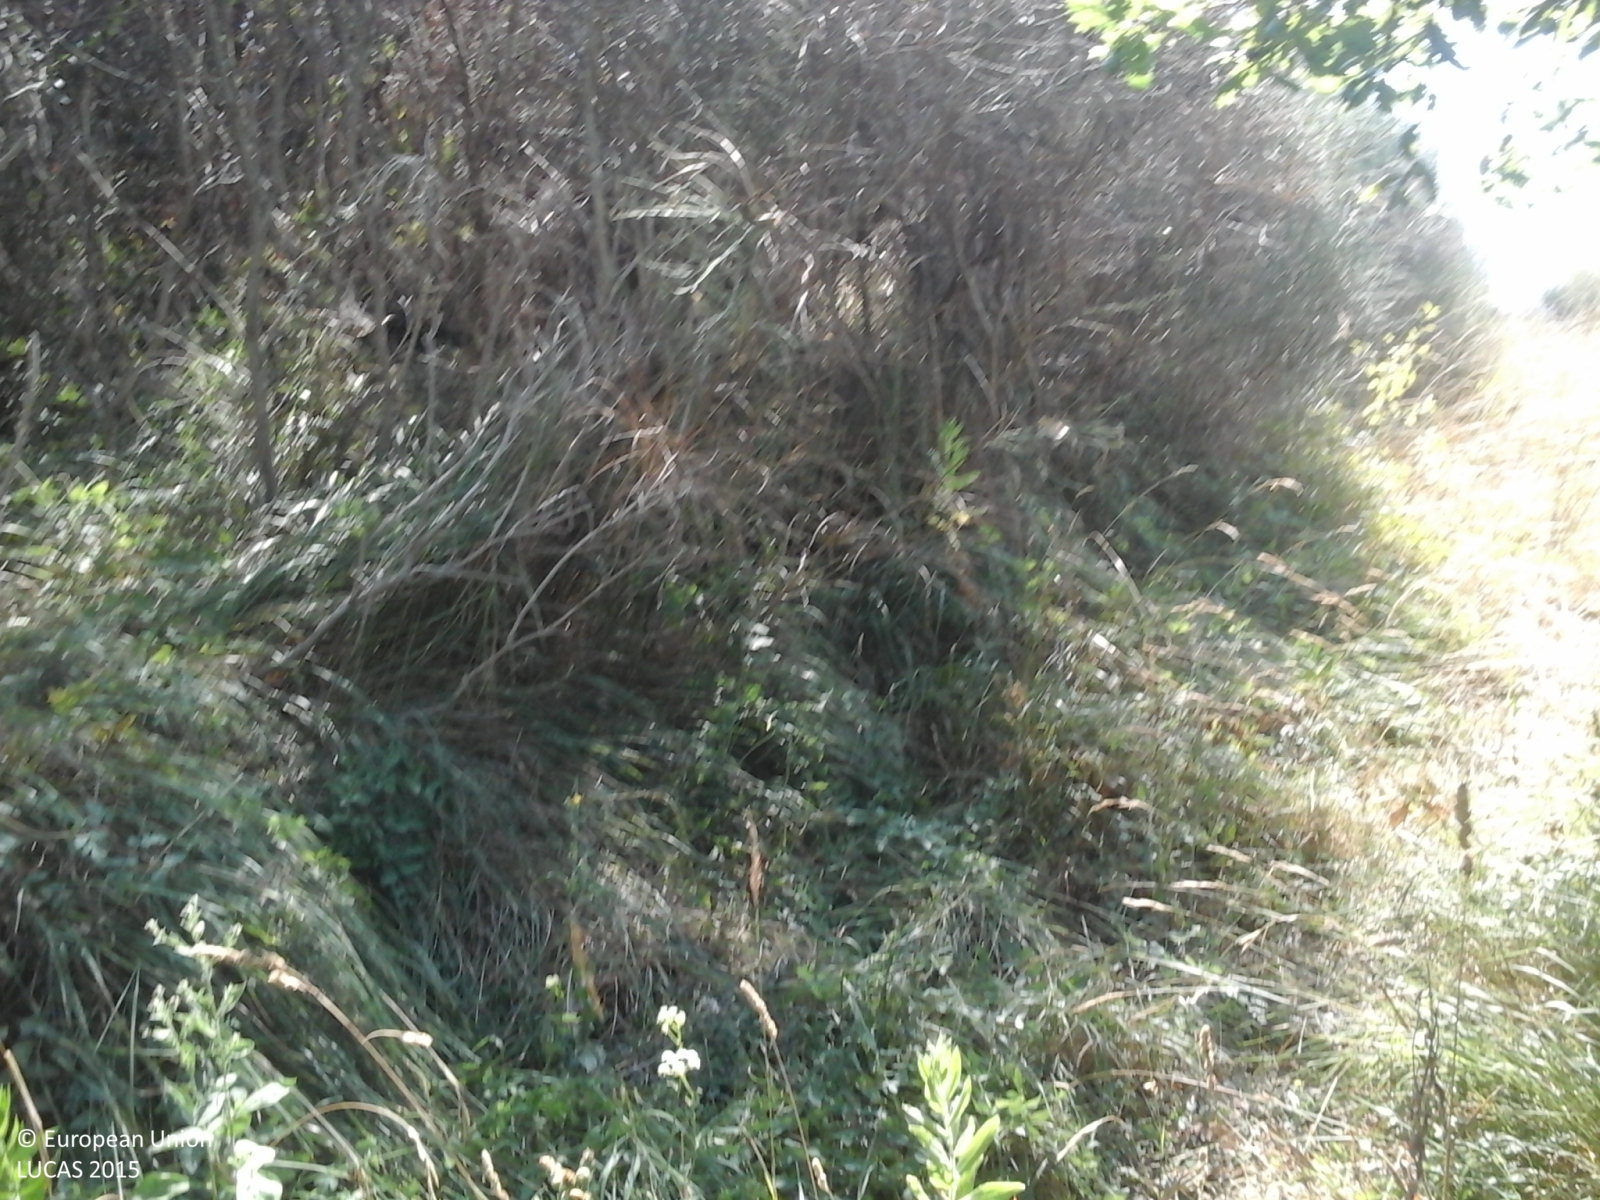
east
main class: Shrubland
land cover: Shrubland without tree cover
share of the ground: > 75 %
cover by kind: shrubs 100 %
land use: Abandoned areas
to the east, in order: Shrubland without tree cover; Tracks; Shrubland without tree cover; Tracks; Shrubland without tree cover; Ditches and canals; Shrubland with sparse tree cover; Olive groves; Artificial constructions in urban areas; Olive groves; Lines of trees; Fences; Paved roads, cycling and walking lanes; Fences; Managed hedges
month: August
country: IT
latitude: 43.8978
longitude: 10.6085
